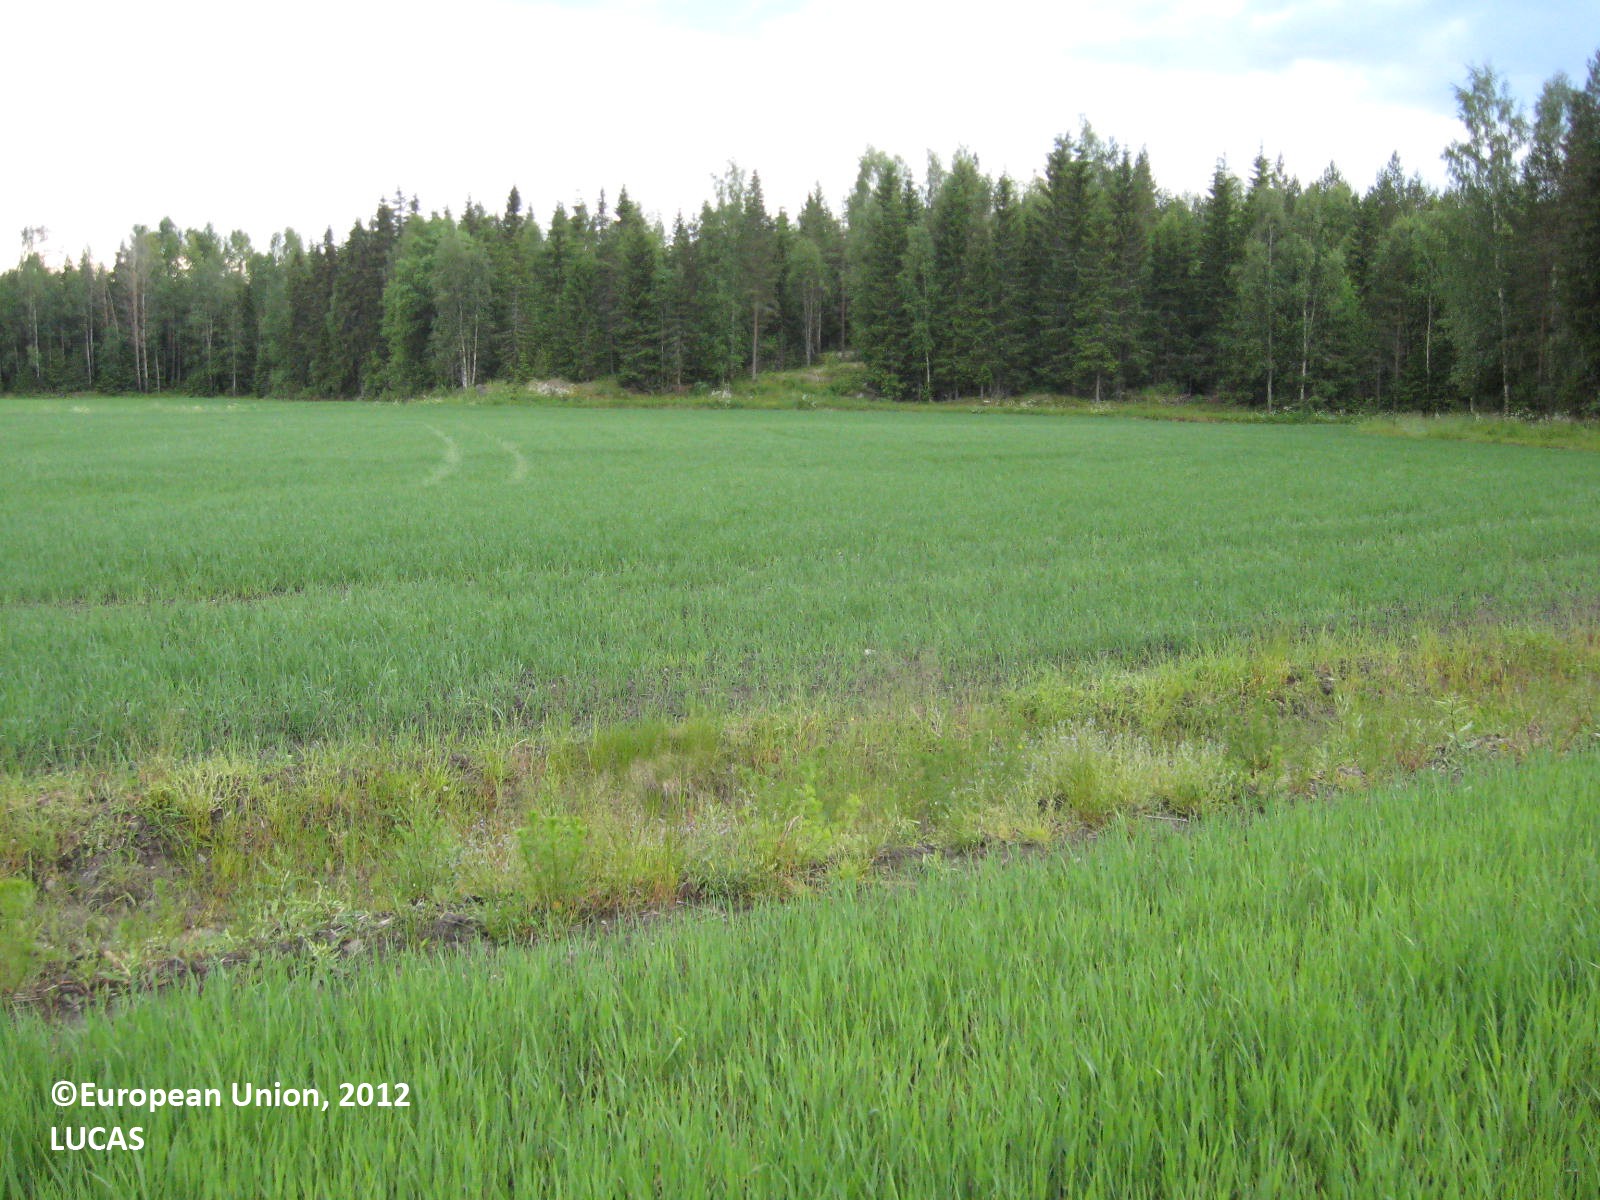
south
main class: Cropland
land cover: Barley
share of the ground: > 75 %
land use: Agriculture (excluding fallow land and kitchen gardens)
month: June
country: FI
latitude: 62.9406
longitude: 22.6047
